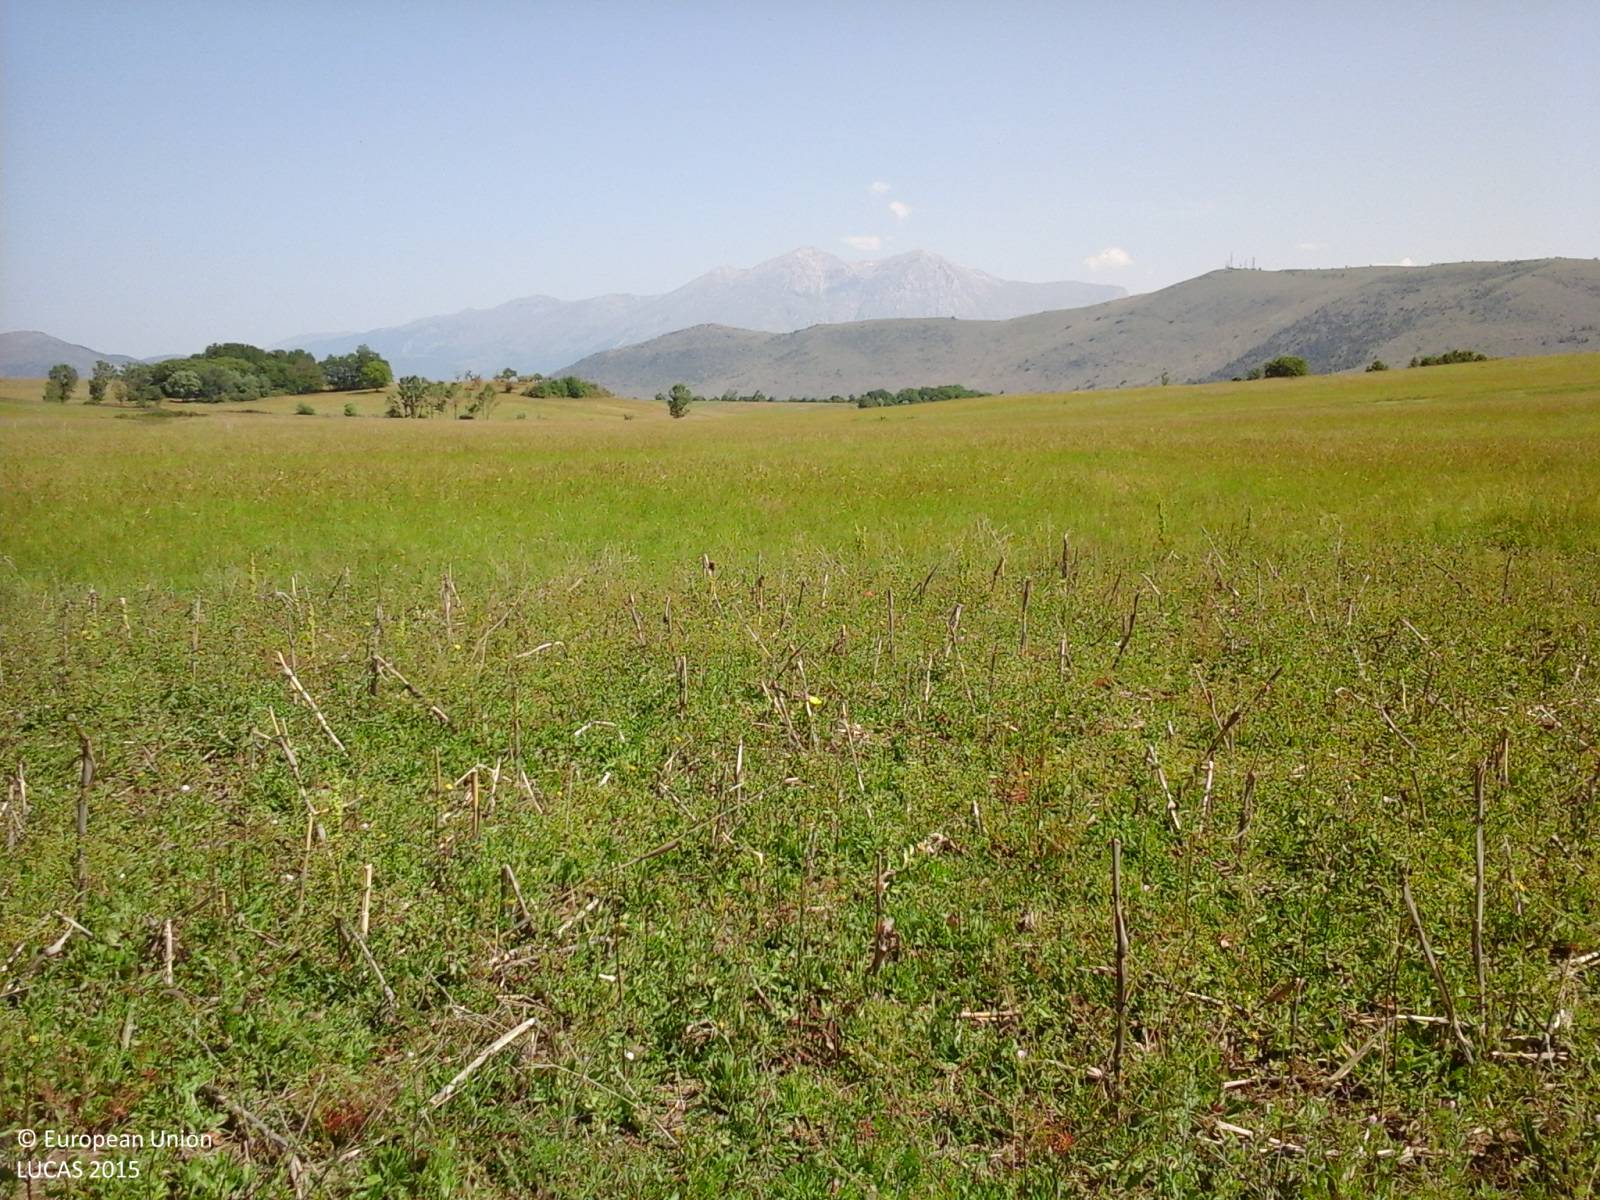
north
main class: Grassland
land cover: Spontaneously vegetated surfaces
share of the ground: > 75 %
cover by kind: herbaceous plants 100 %
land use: Fallow land
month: June
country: IT
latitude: 42.0010
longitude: 13.3807
